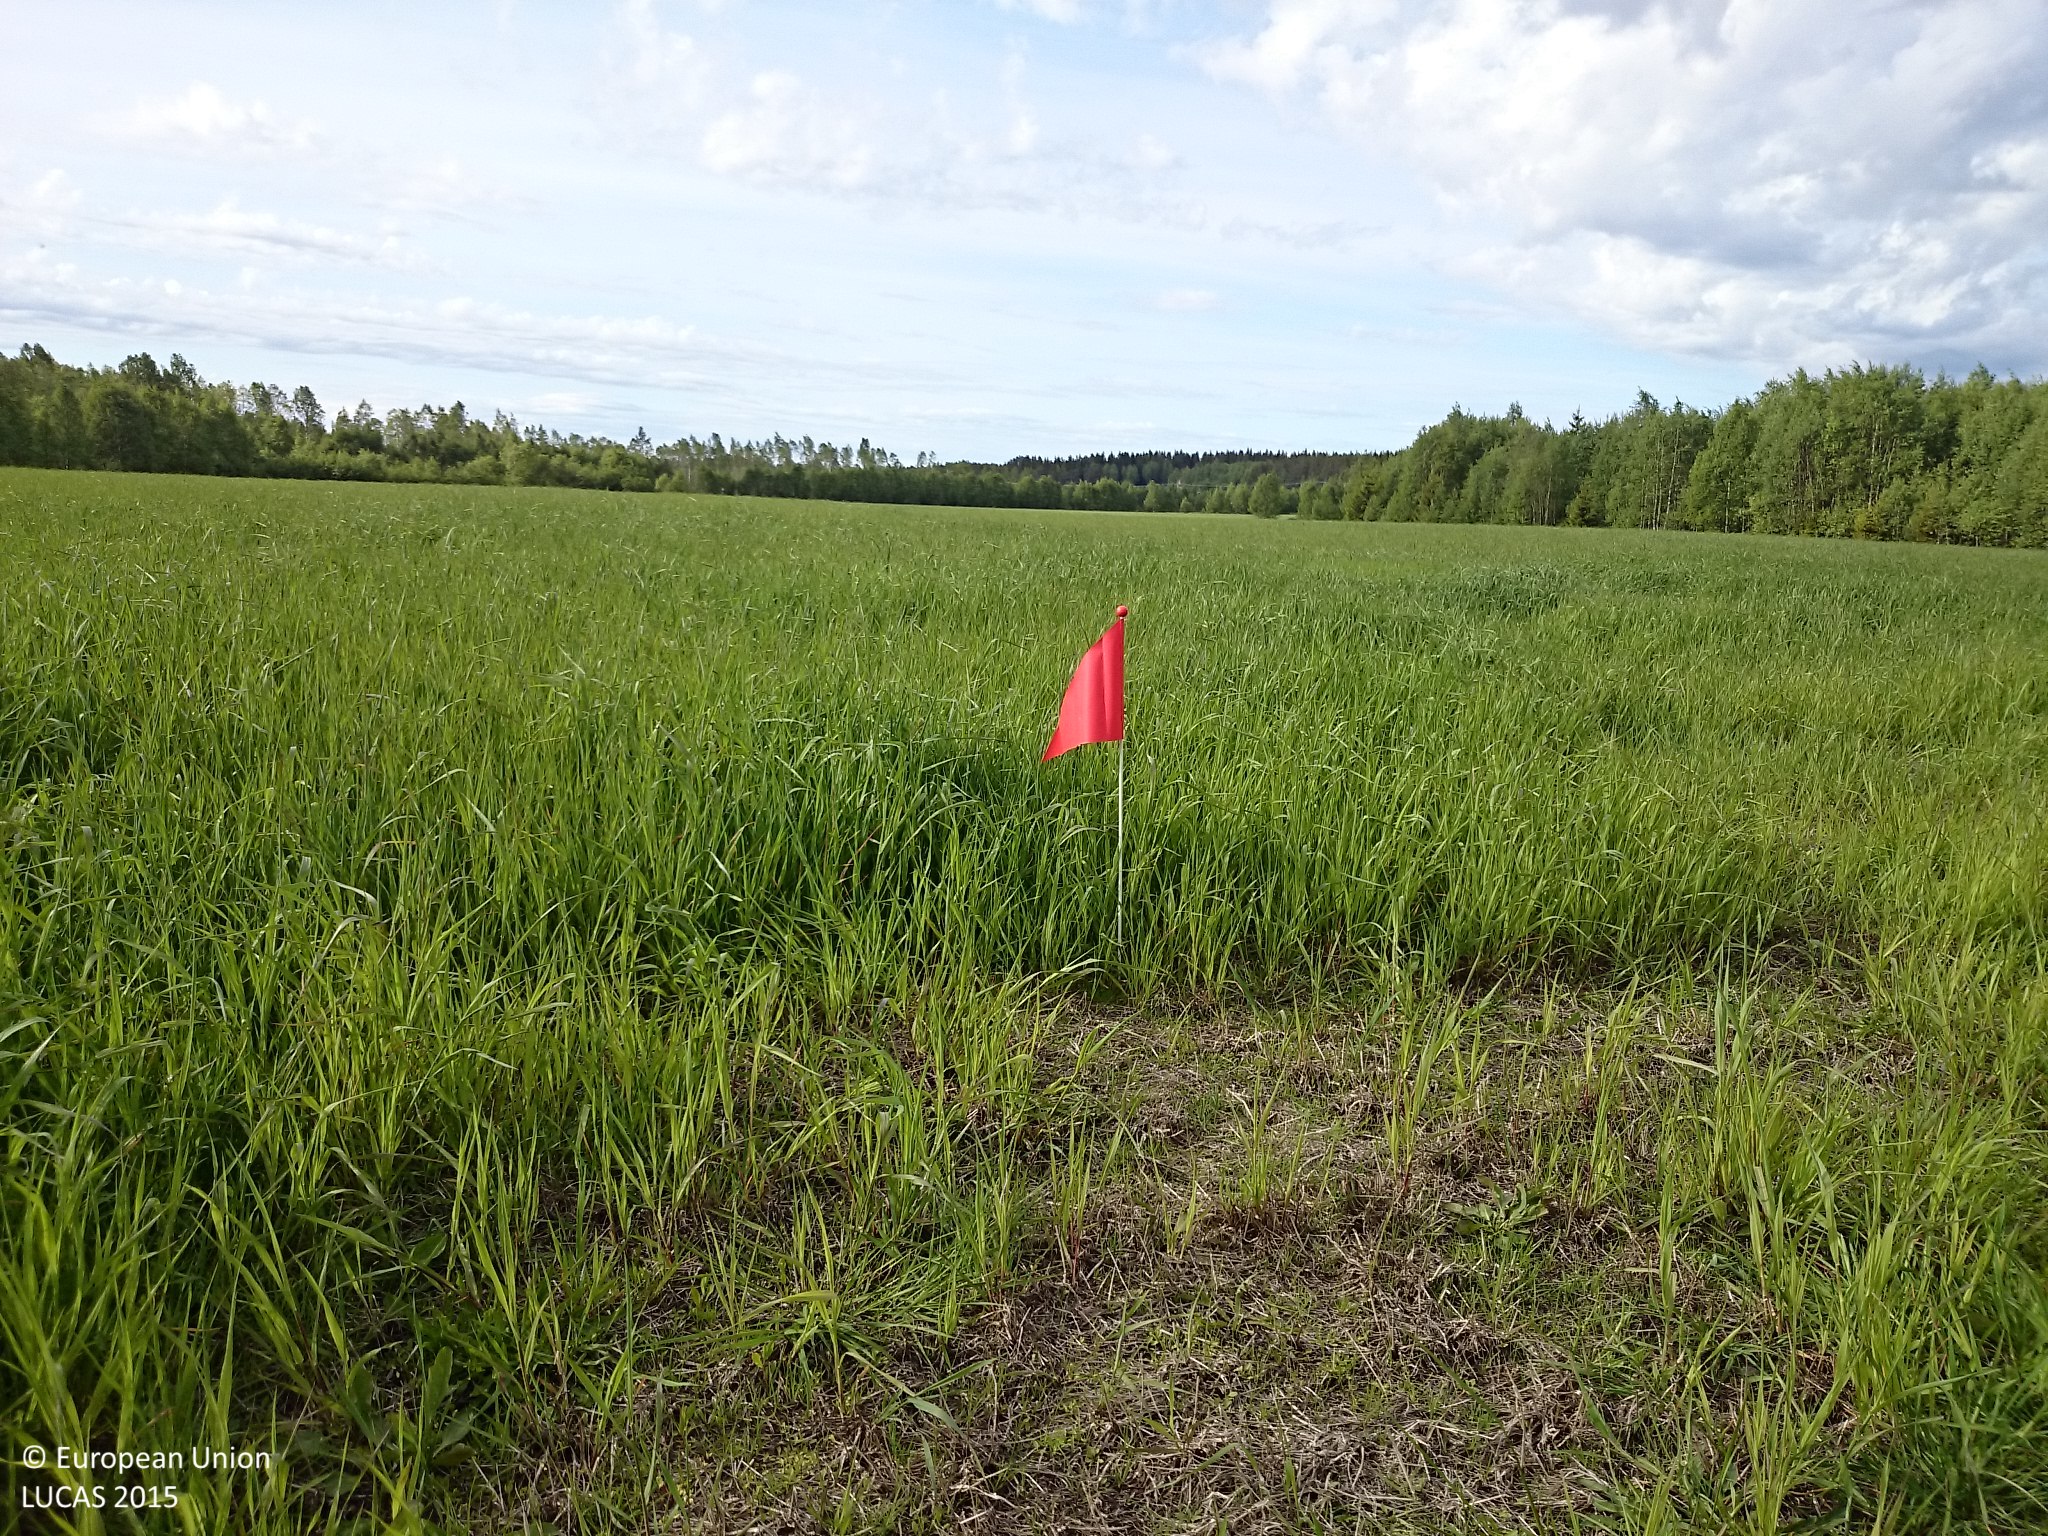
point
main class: Cropland
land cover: Mixed cereals for fodder
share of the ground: > 75 %
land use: Agriculture (excluding fallow land and kitchen gardens)
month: June
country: SE
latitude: 64.0870
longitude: 20.7505
